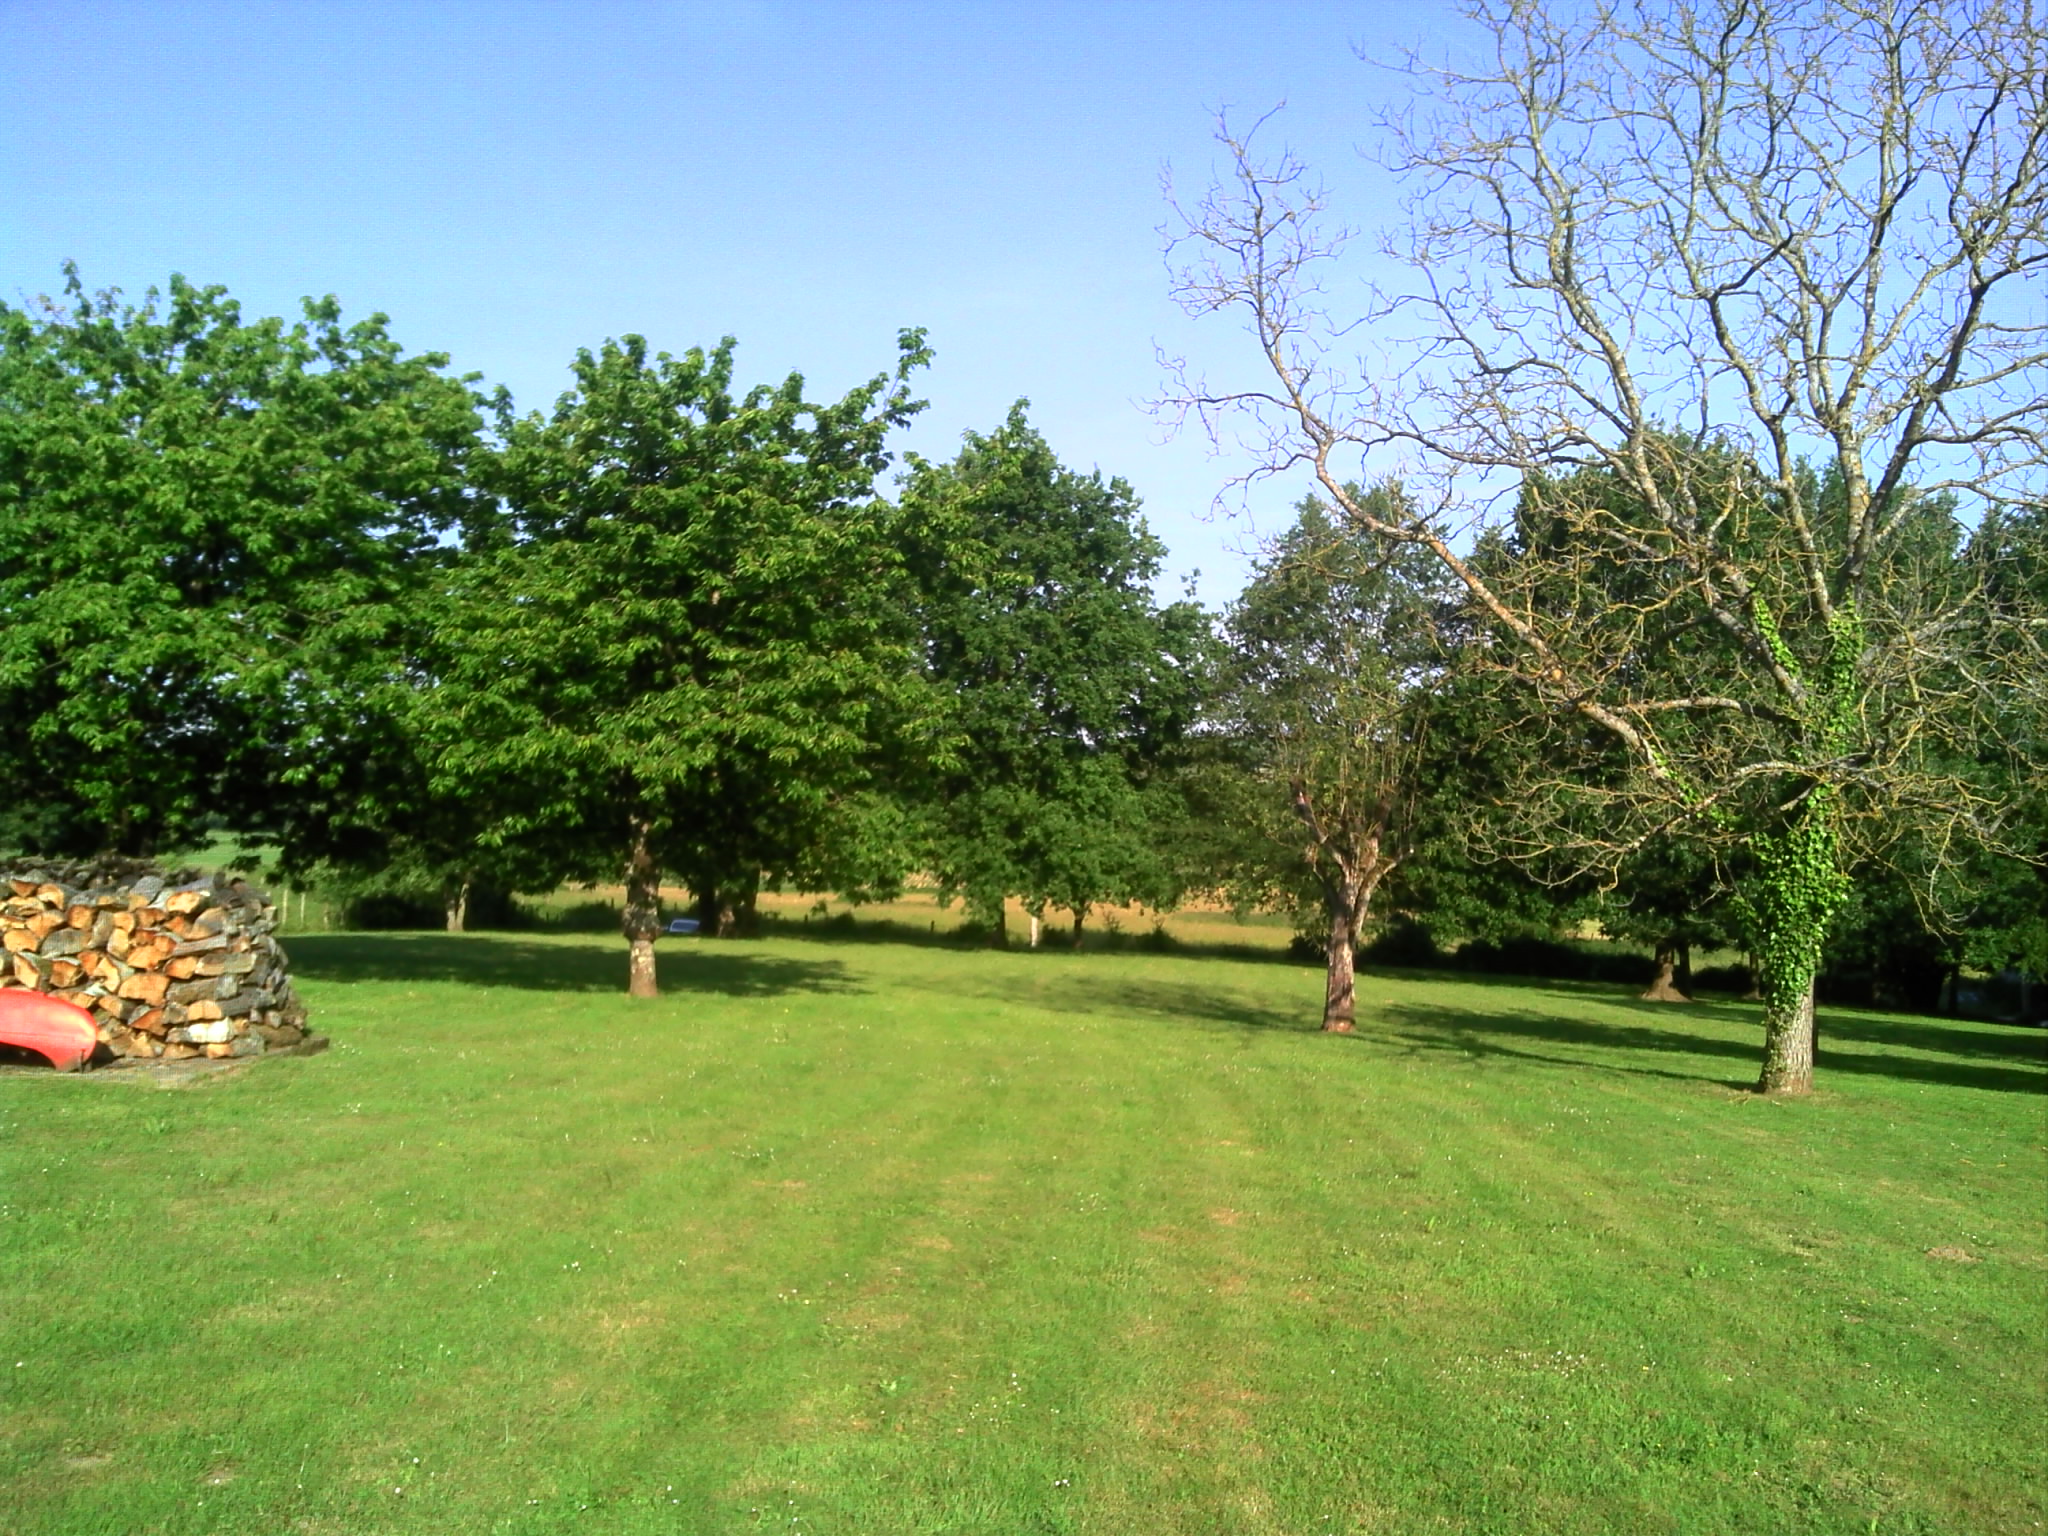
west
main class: Grassland
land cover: Grassland with sparse tree/shrub cover
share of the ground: > 75 %
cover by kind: herbaceous plants 90 %, broadleaved forest trees 5 %, shrubs 5 %
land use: Residential
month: May
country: FR
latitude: 46.5797
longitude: 5.0563
